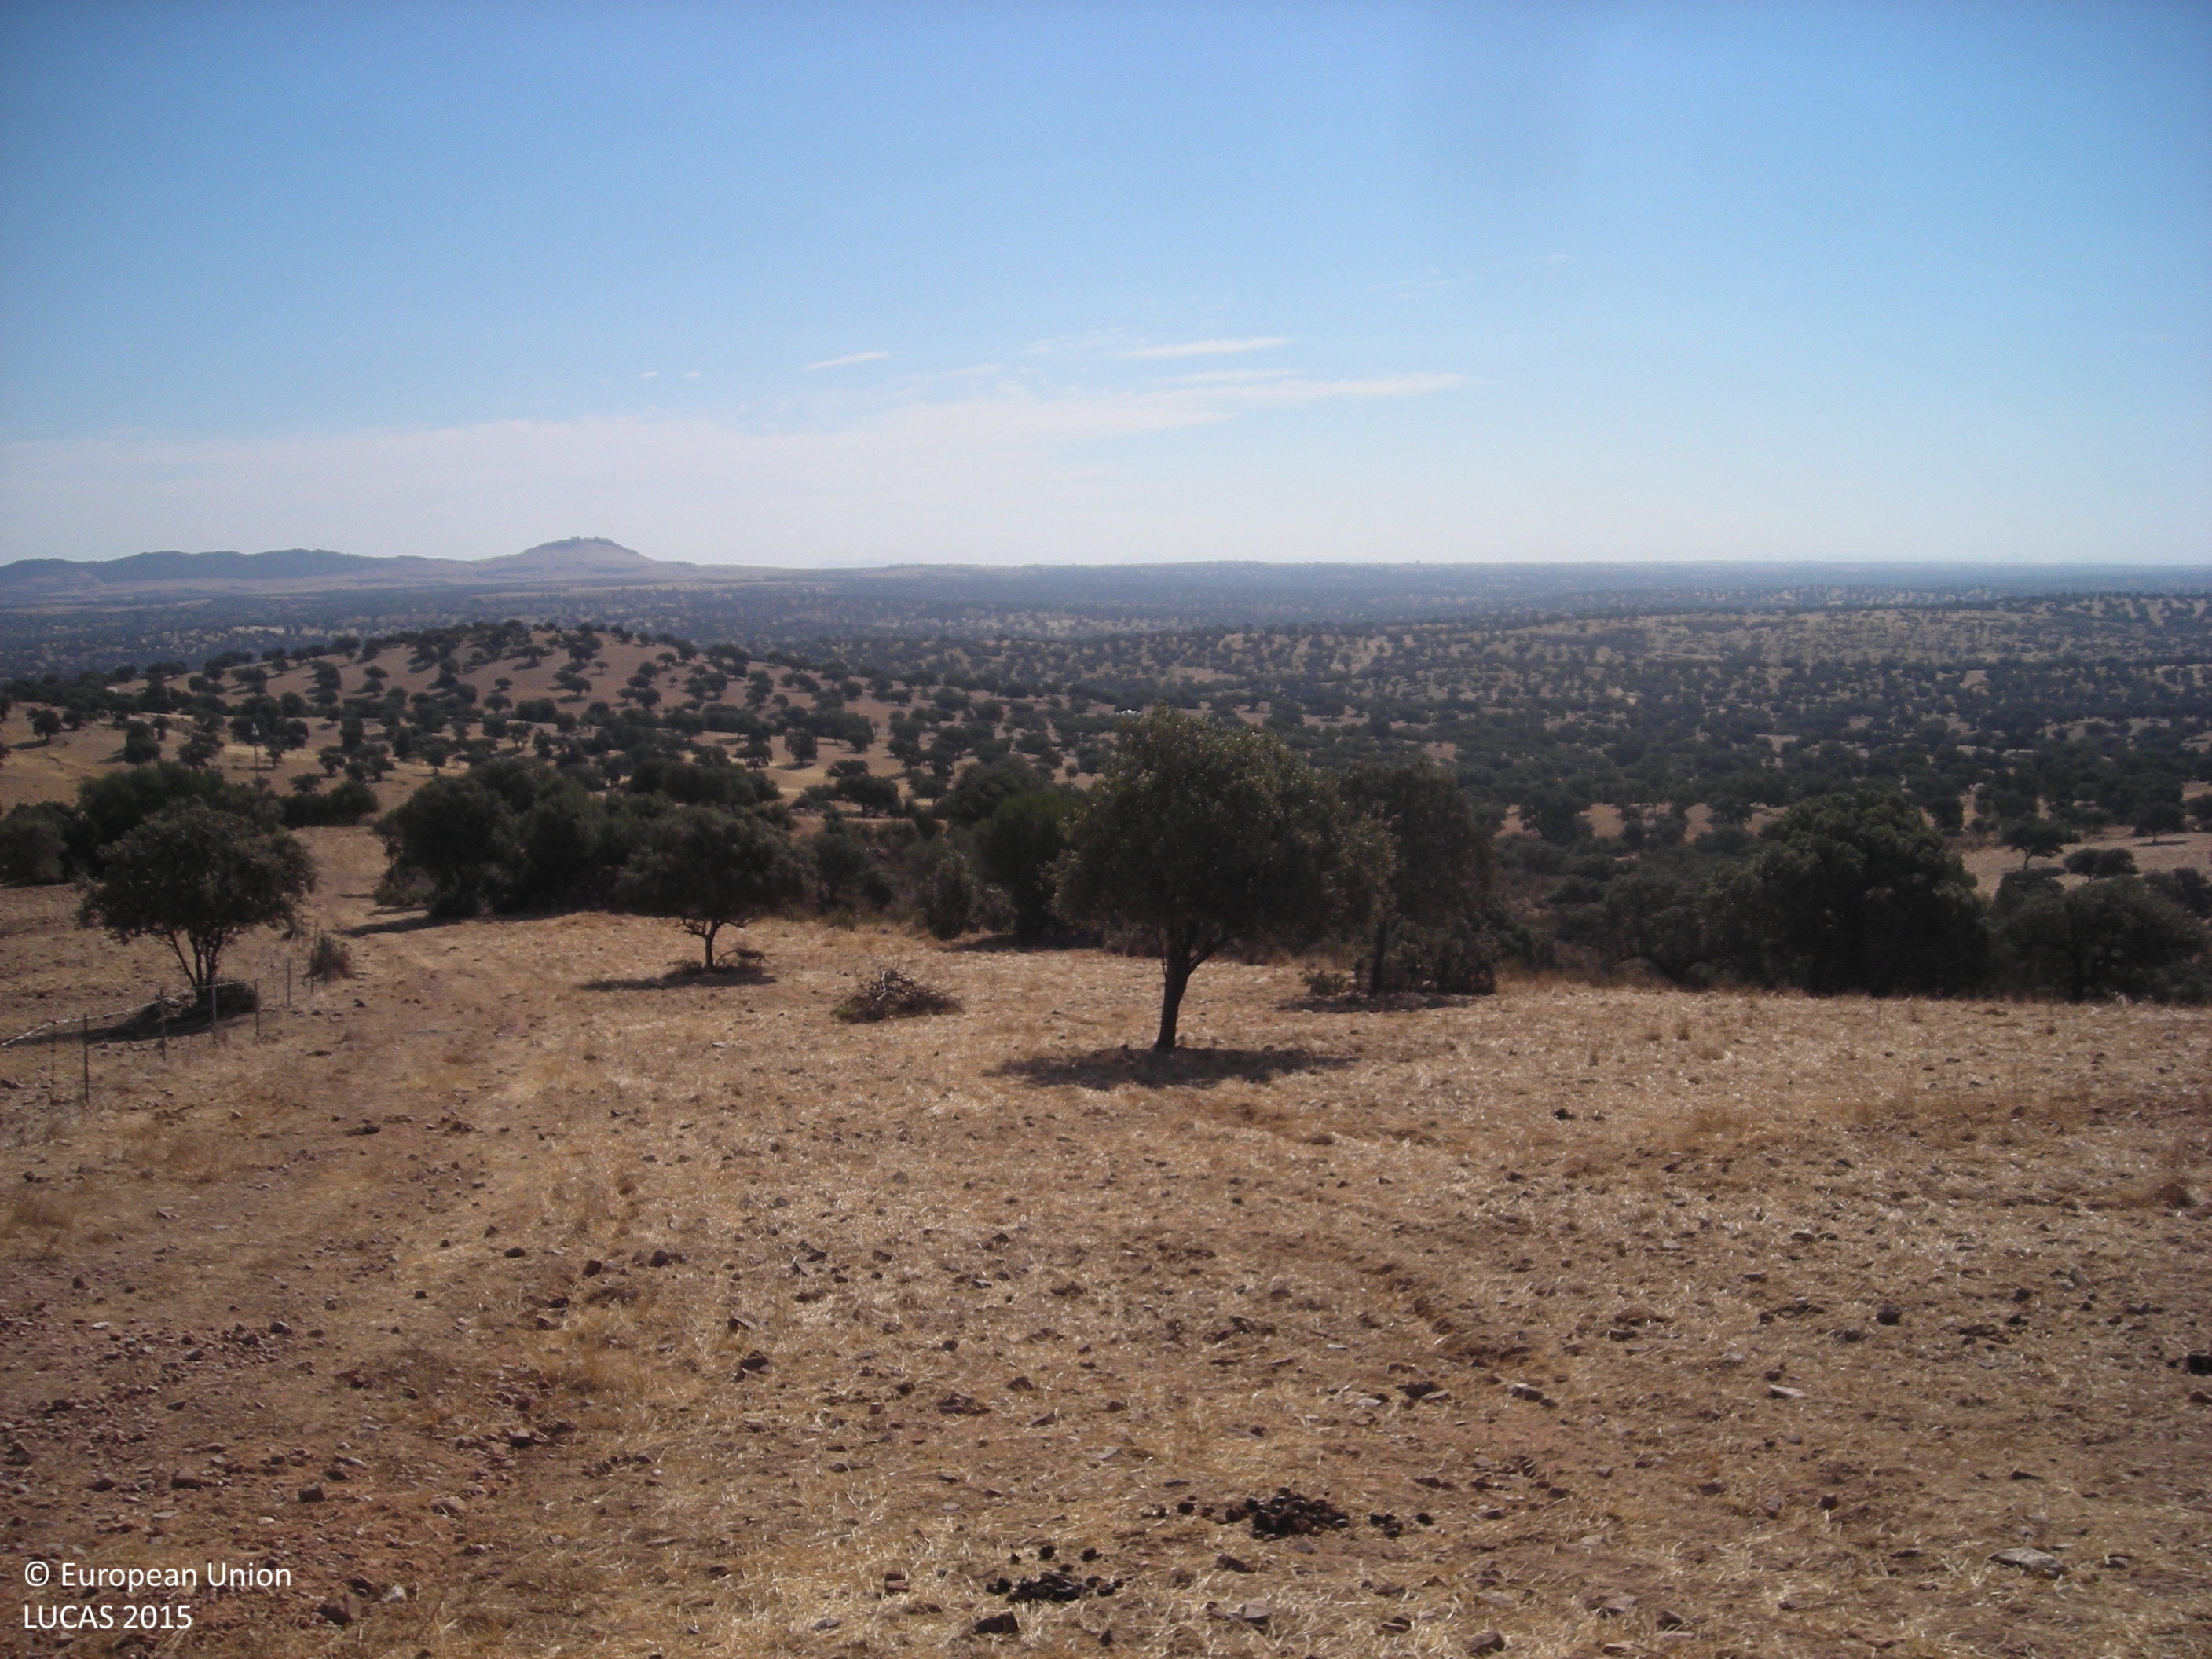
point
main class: Woodland
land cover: Broadleaved woodland
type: broadleaved evergreen forest
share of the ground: 25 - 50 %
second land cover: Grassland without tree/shrub cover
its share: 50 - 75 %
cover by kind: herbaceous plants 60 %, broadleaved forest trees 40 %
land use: Forestry
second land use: Agriculture (excluding fallow land and kitchen gardens)
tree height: > 5 m
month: July
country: ES
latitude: 38.8598
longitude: -5.8468
